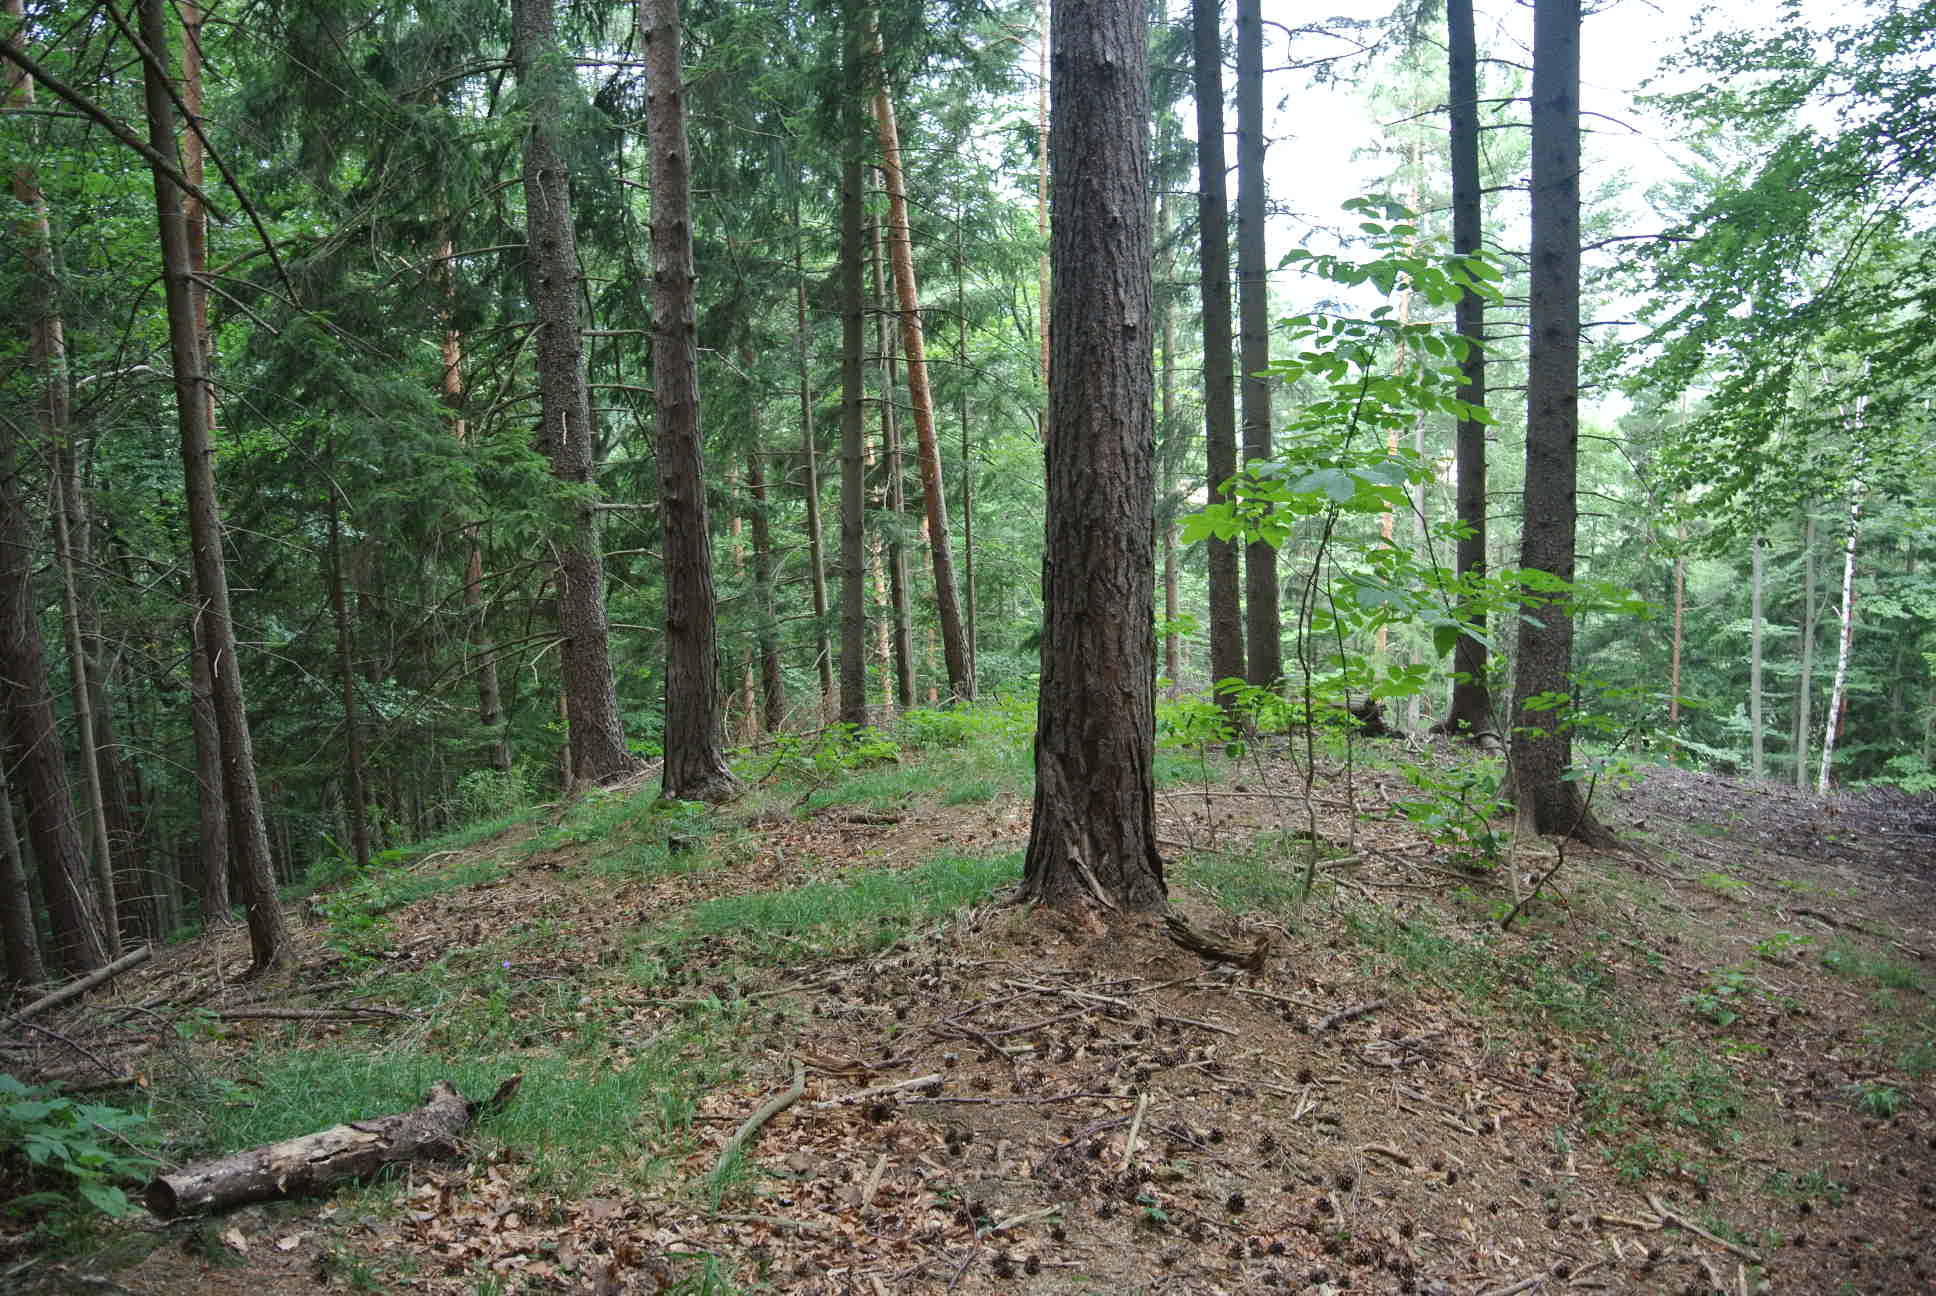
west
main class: Woodland
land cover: Other mixed woodland
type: alpine coniferous forest
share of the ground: > 75 %
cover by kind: coniferous forest trees 60 %, broadleaved forest trees 40 %
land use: Forestry
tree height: > 5 m
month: July
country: AT
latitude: 47.6732
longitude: 16.1431
